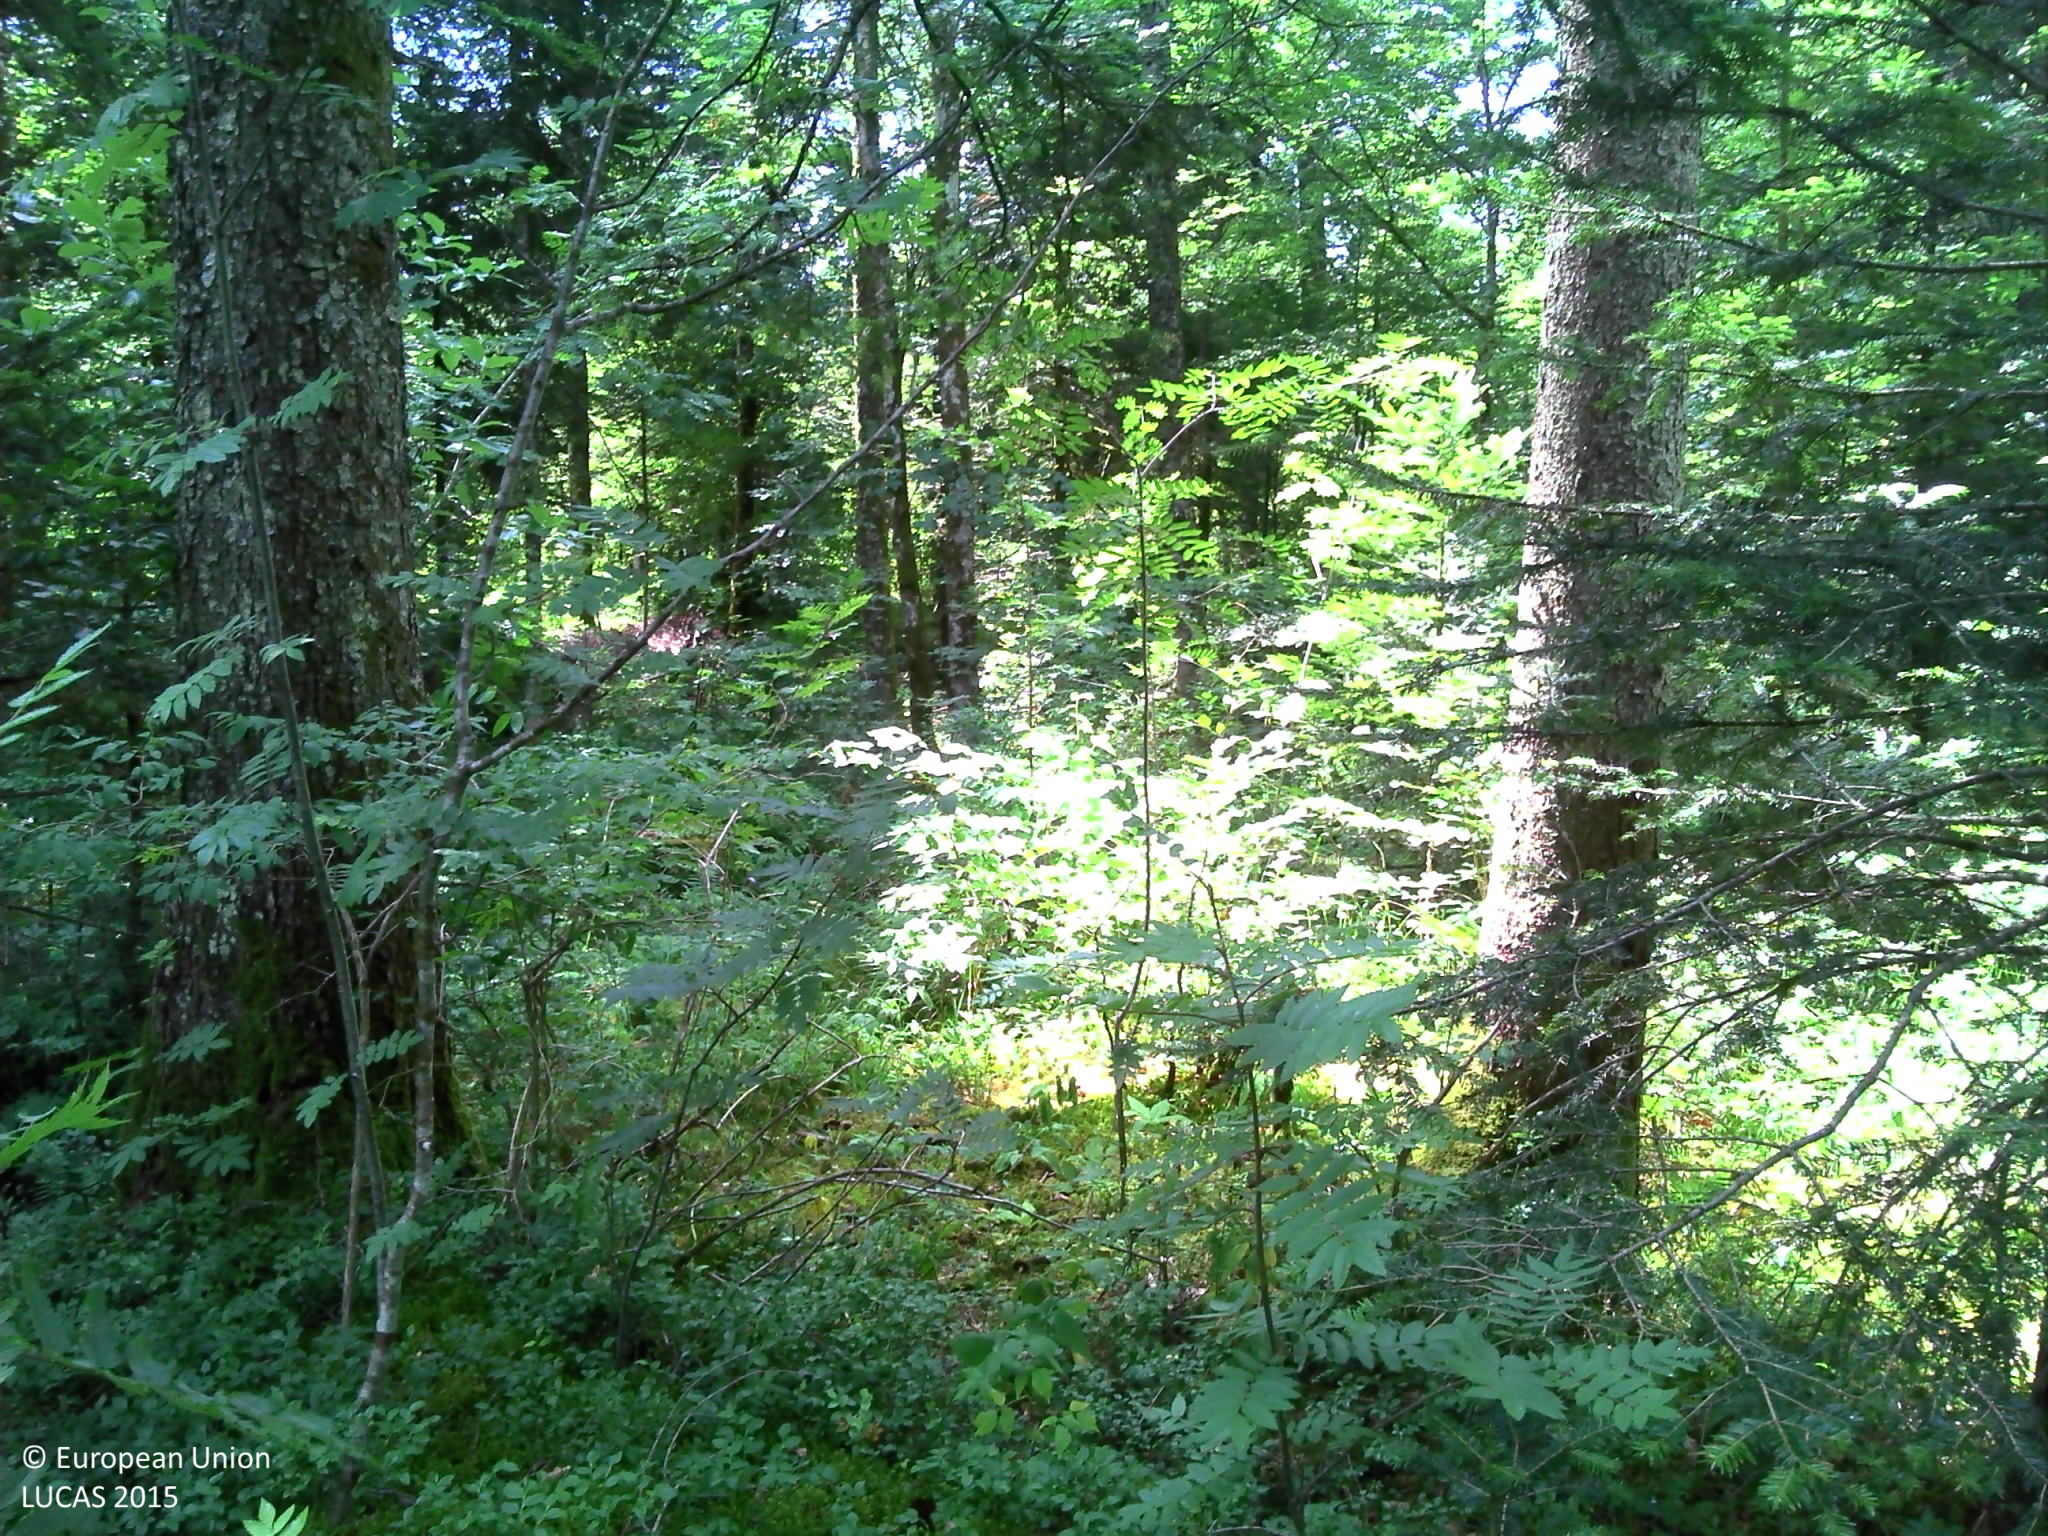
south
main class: Woodland
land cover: Other mixed woodland
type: mountainous beech forest
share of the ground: > 75 %
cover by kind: coniferous forest trees 30 %, broadleaved forest trees 30 %, lichens and mosses 15 %, consolidated bare surface 15 %, herbaceous plants 10 %
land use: Forestry
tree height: > 5 m
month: July
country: FR
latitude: 46.7513
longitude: 6.1670
